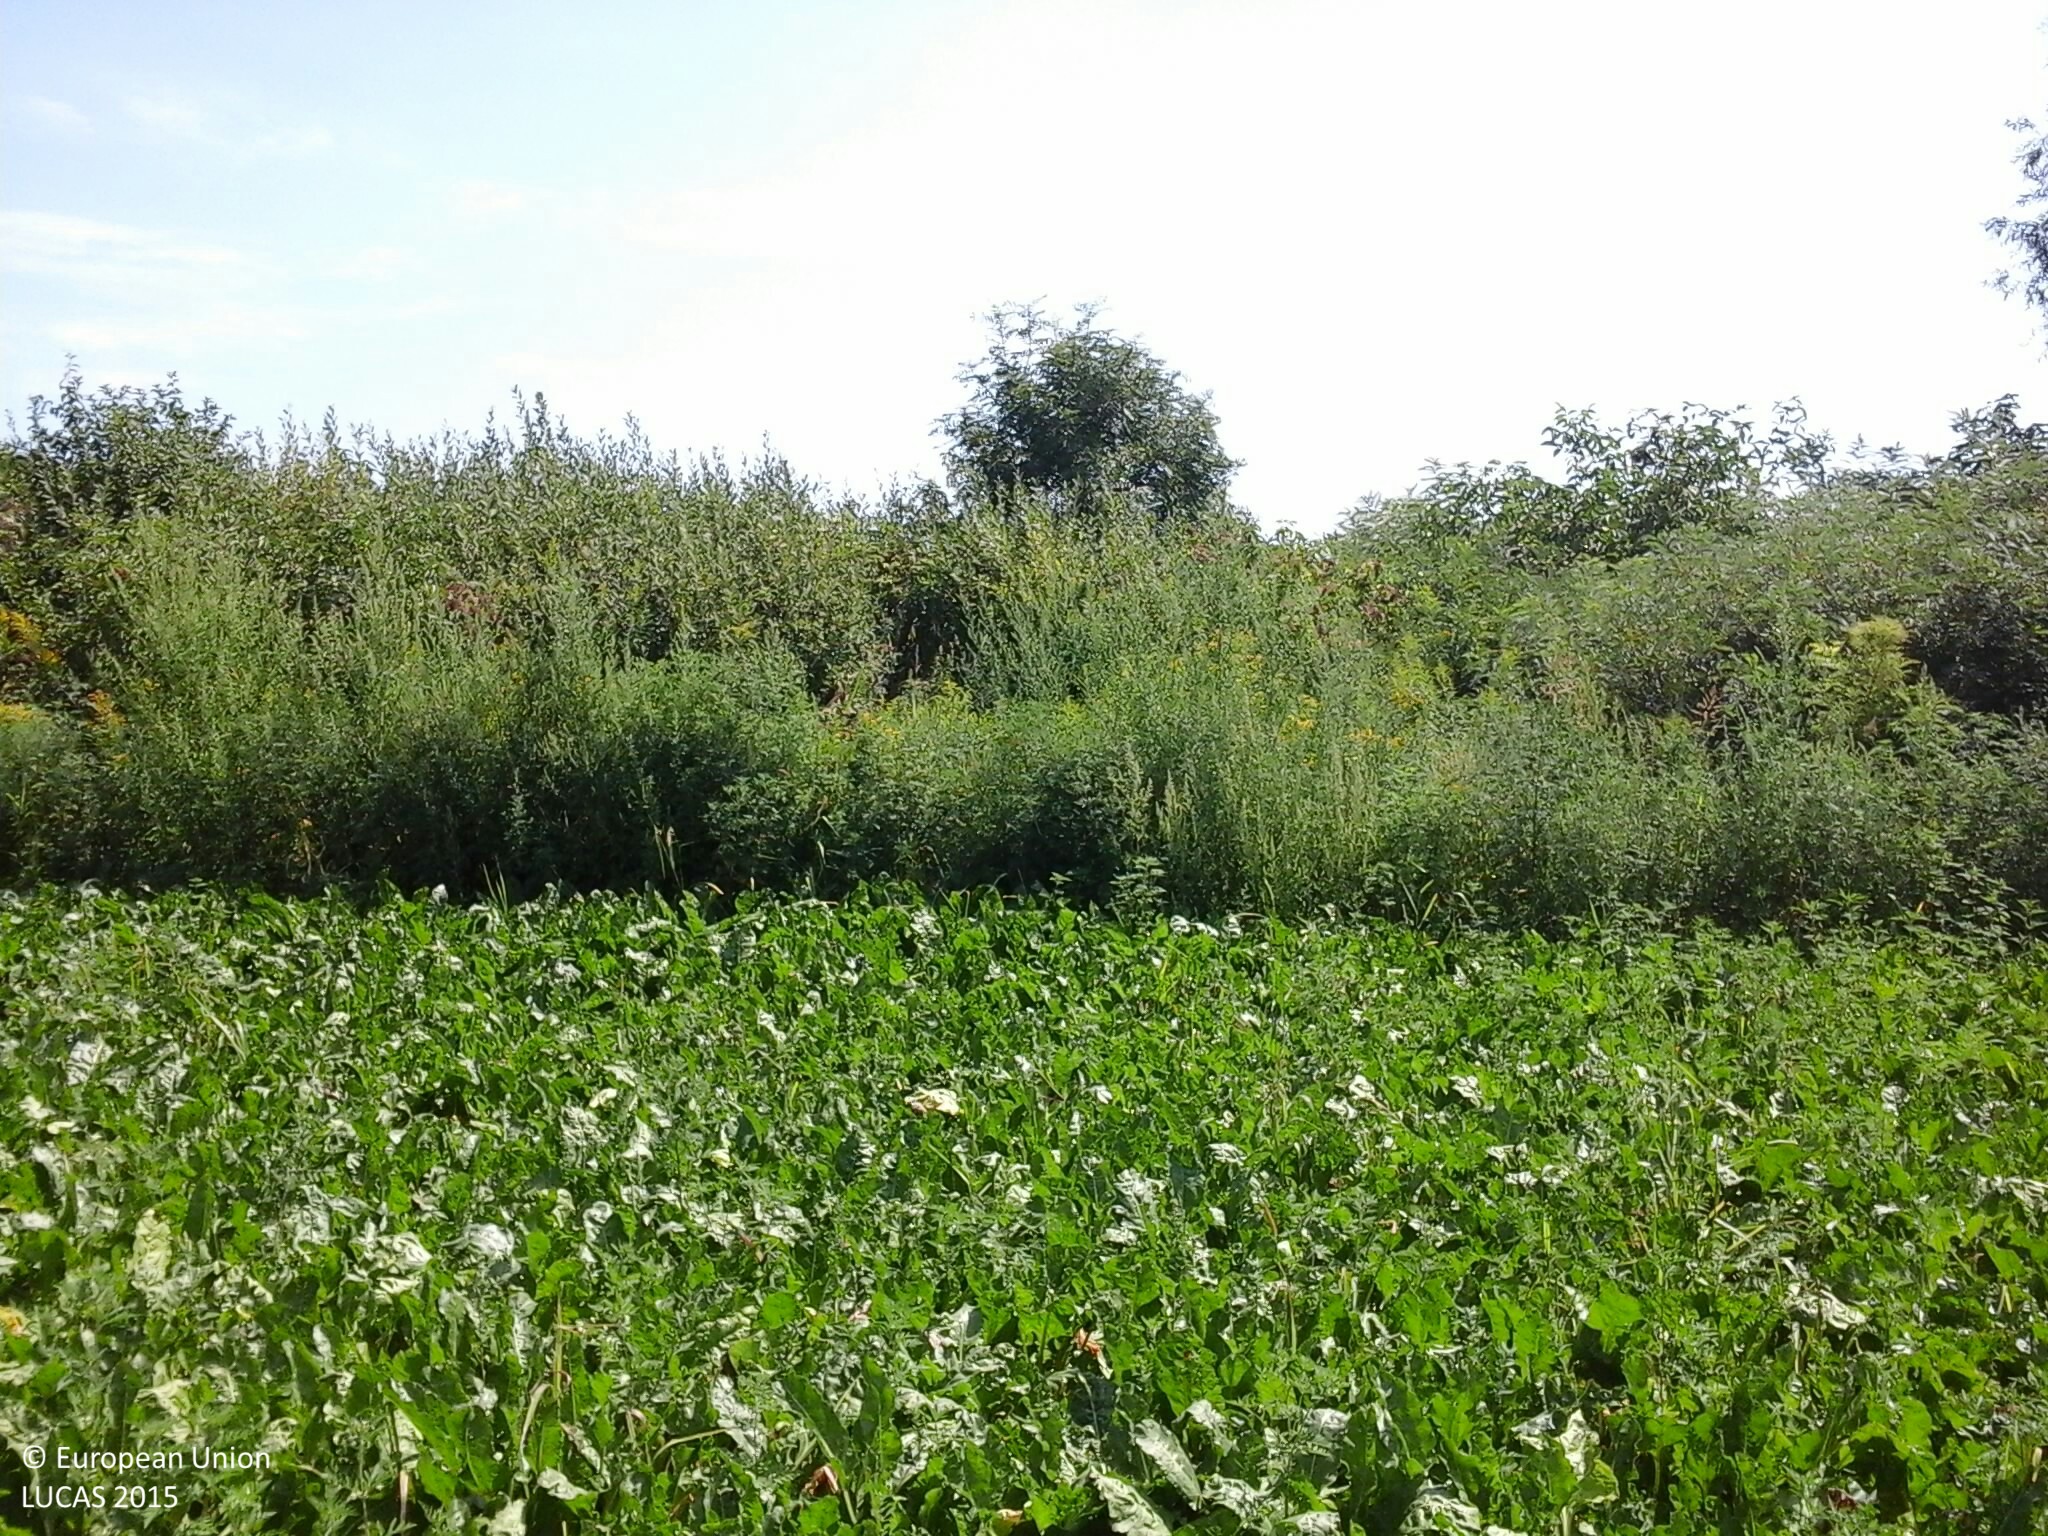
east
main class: Cropland
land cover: Sugar beet
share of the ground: > 75 %
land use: Agriculture (excluding fallow land and kitchen gardens)
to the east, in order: Sugar beet; Shruby margins; Ditches and canals; Shruby margins; Maize
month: August
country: HU
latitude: 46.6968
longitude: 18.0773
